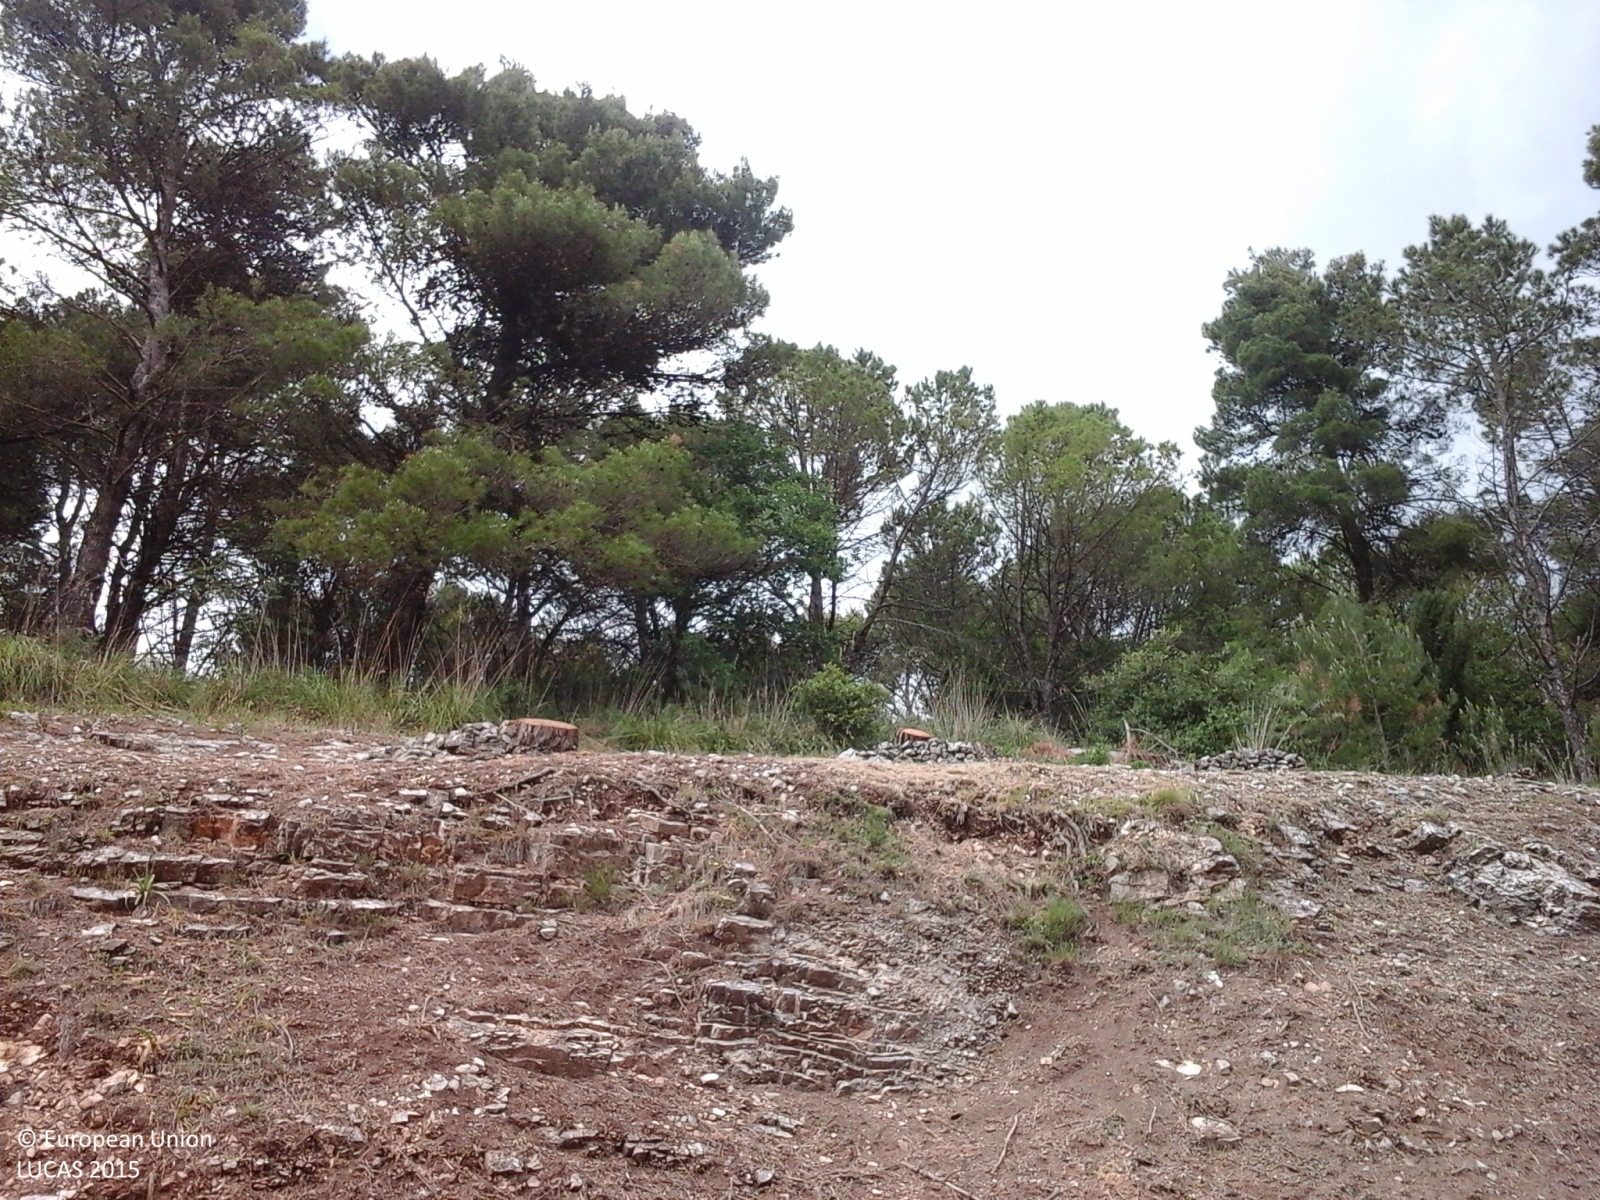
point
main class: Woodland
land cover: Pine dominated mixed woodland
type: coniferous forest of the mediterranean region
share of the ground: > 75 %
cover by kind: coniferous forest trees 50 %, broadleaved forest trees 30 %, shrubs 15 %, herbaceous plants 5 %
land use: Forestry
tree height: > 5 m
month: June
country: IT
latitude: 37.6089
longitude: 13.5418
